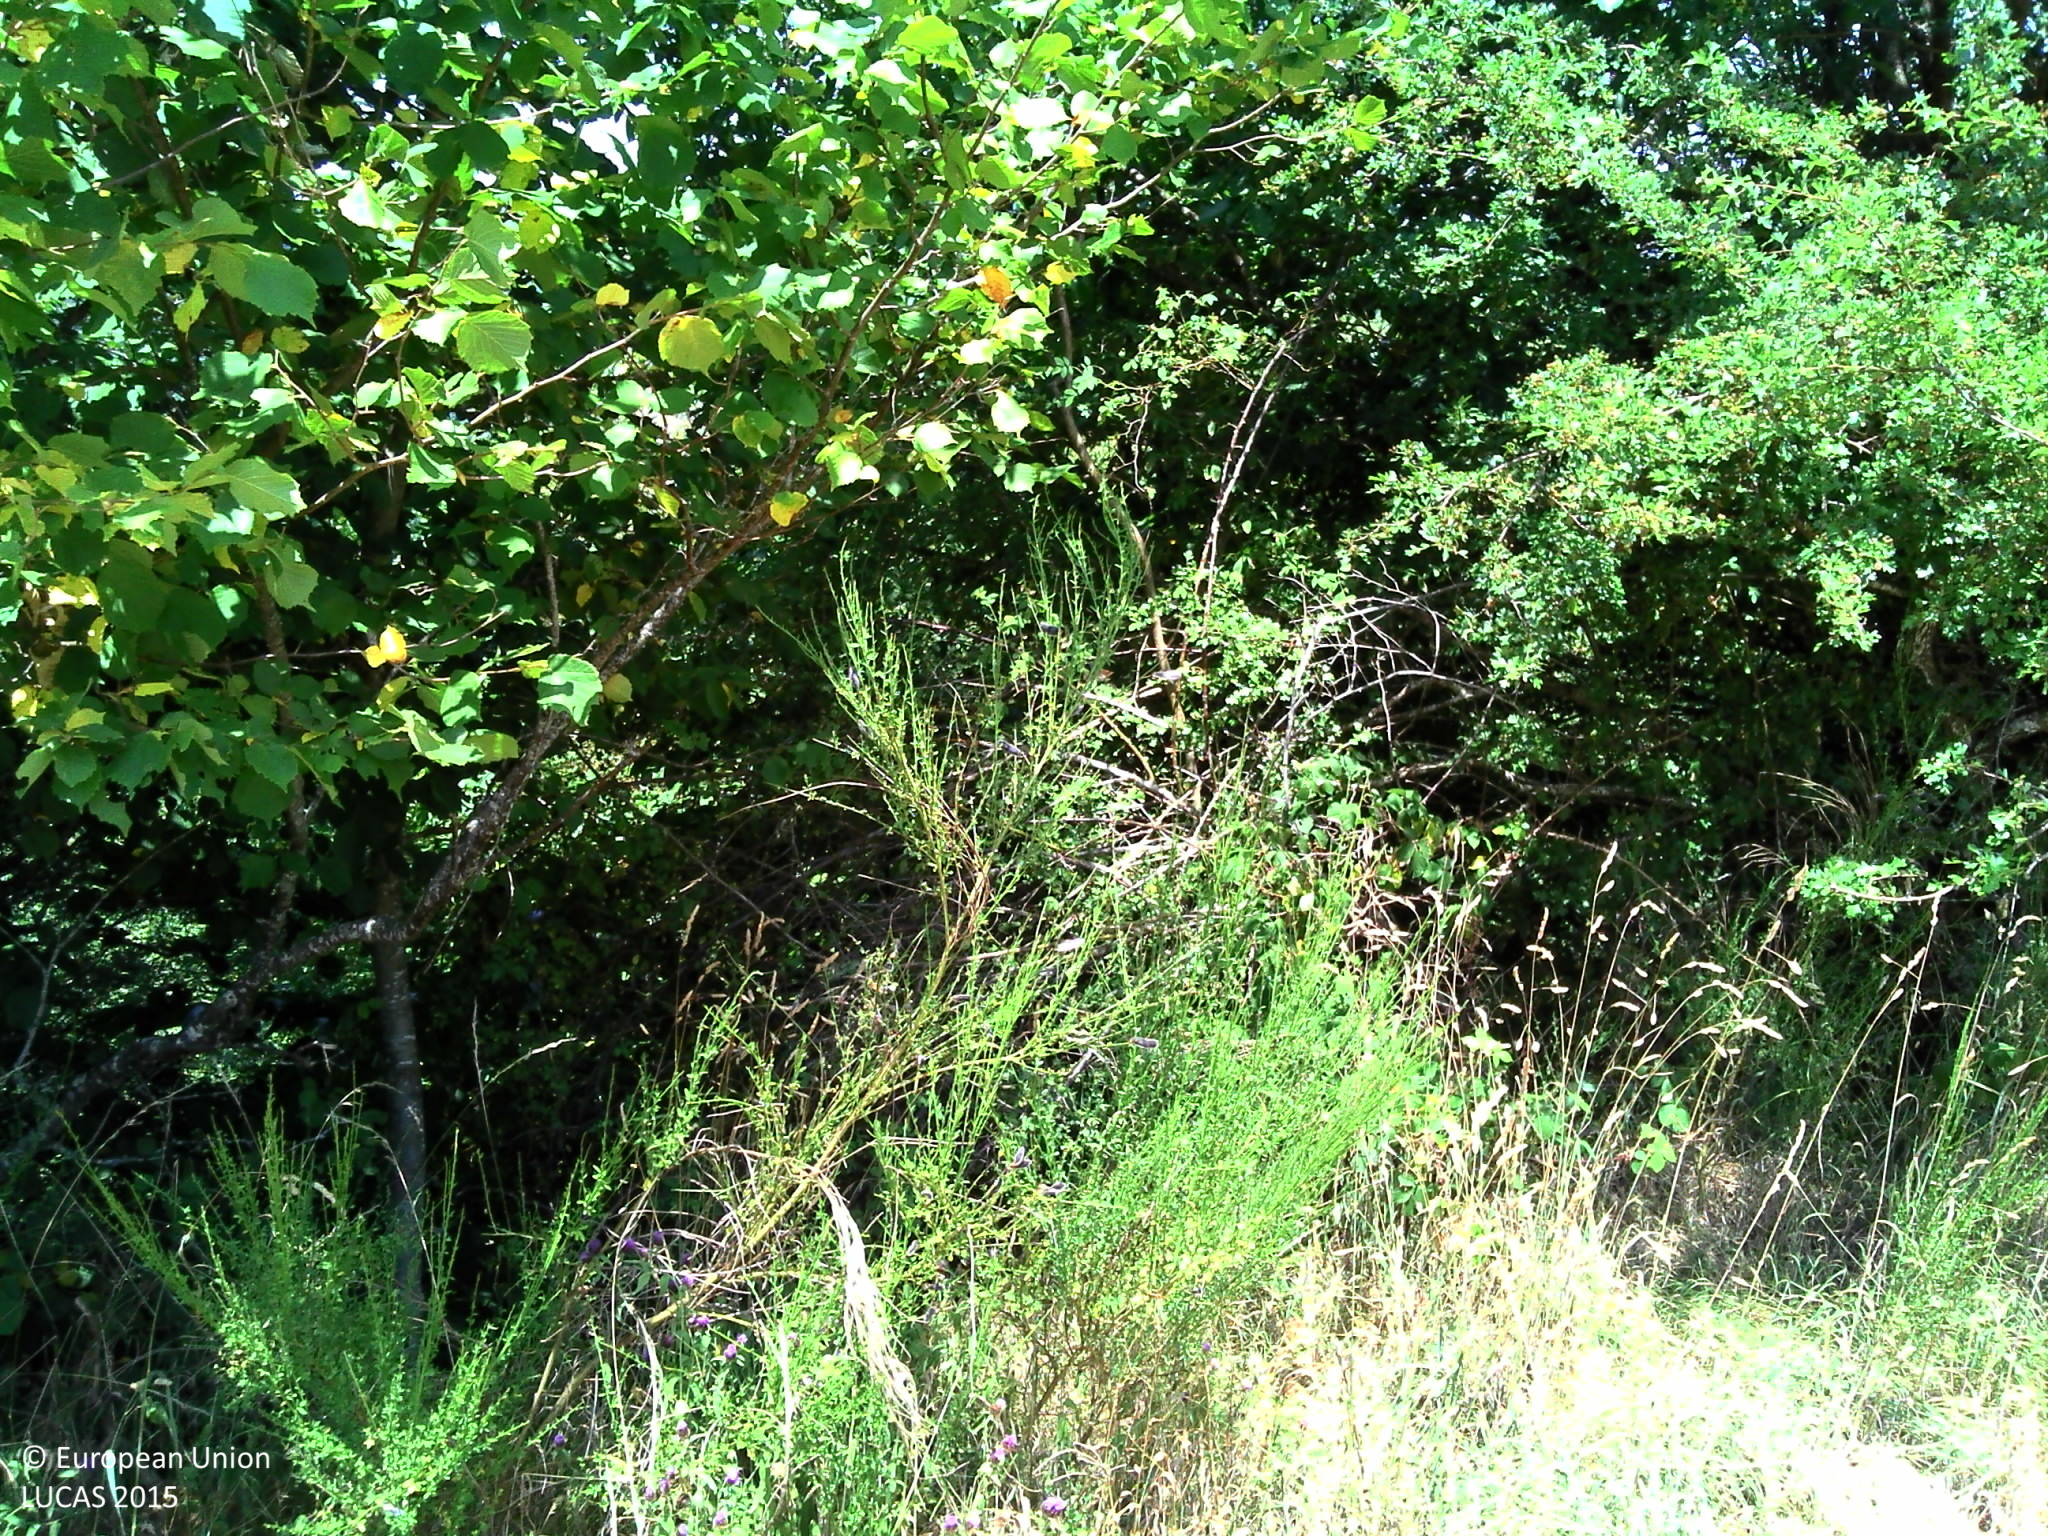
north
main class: Grassland
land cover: Grassland without tree/shrub cover
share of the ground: > 75 %
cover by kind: herbaceous plants 100 %
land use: Agriculture (excluding fallow land and kitchen gardens)
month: July
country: FR
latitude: 44.4974
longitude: 3.0494
